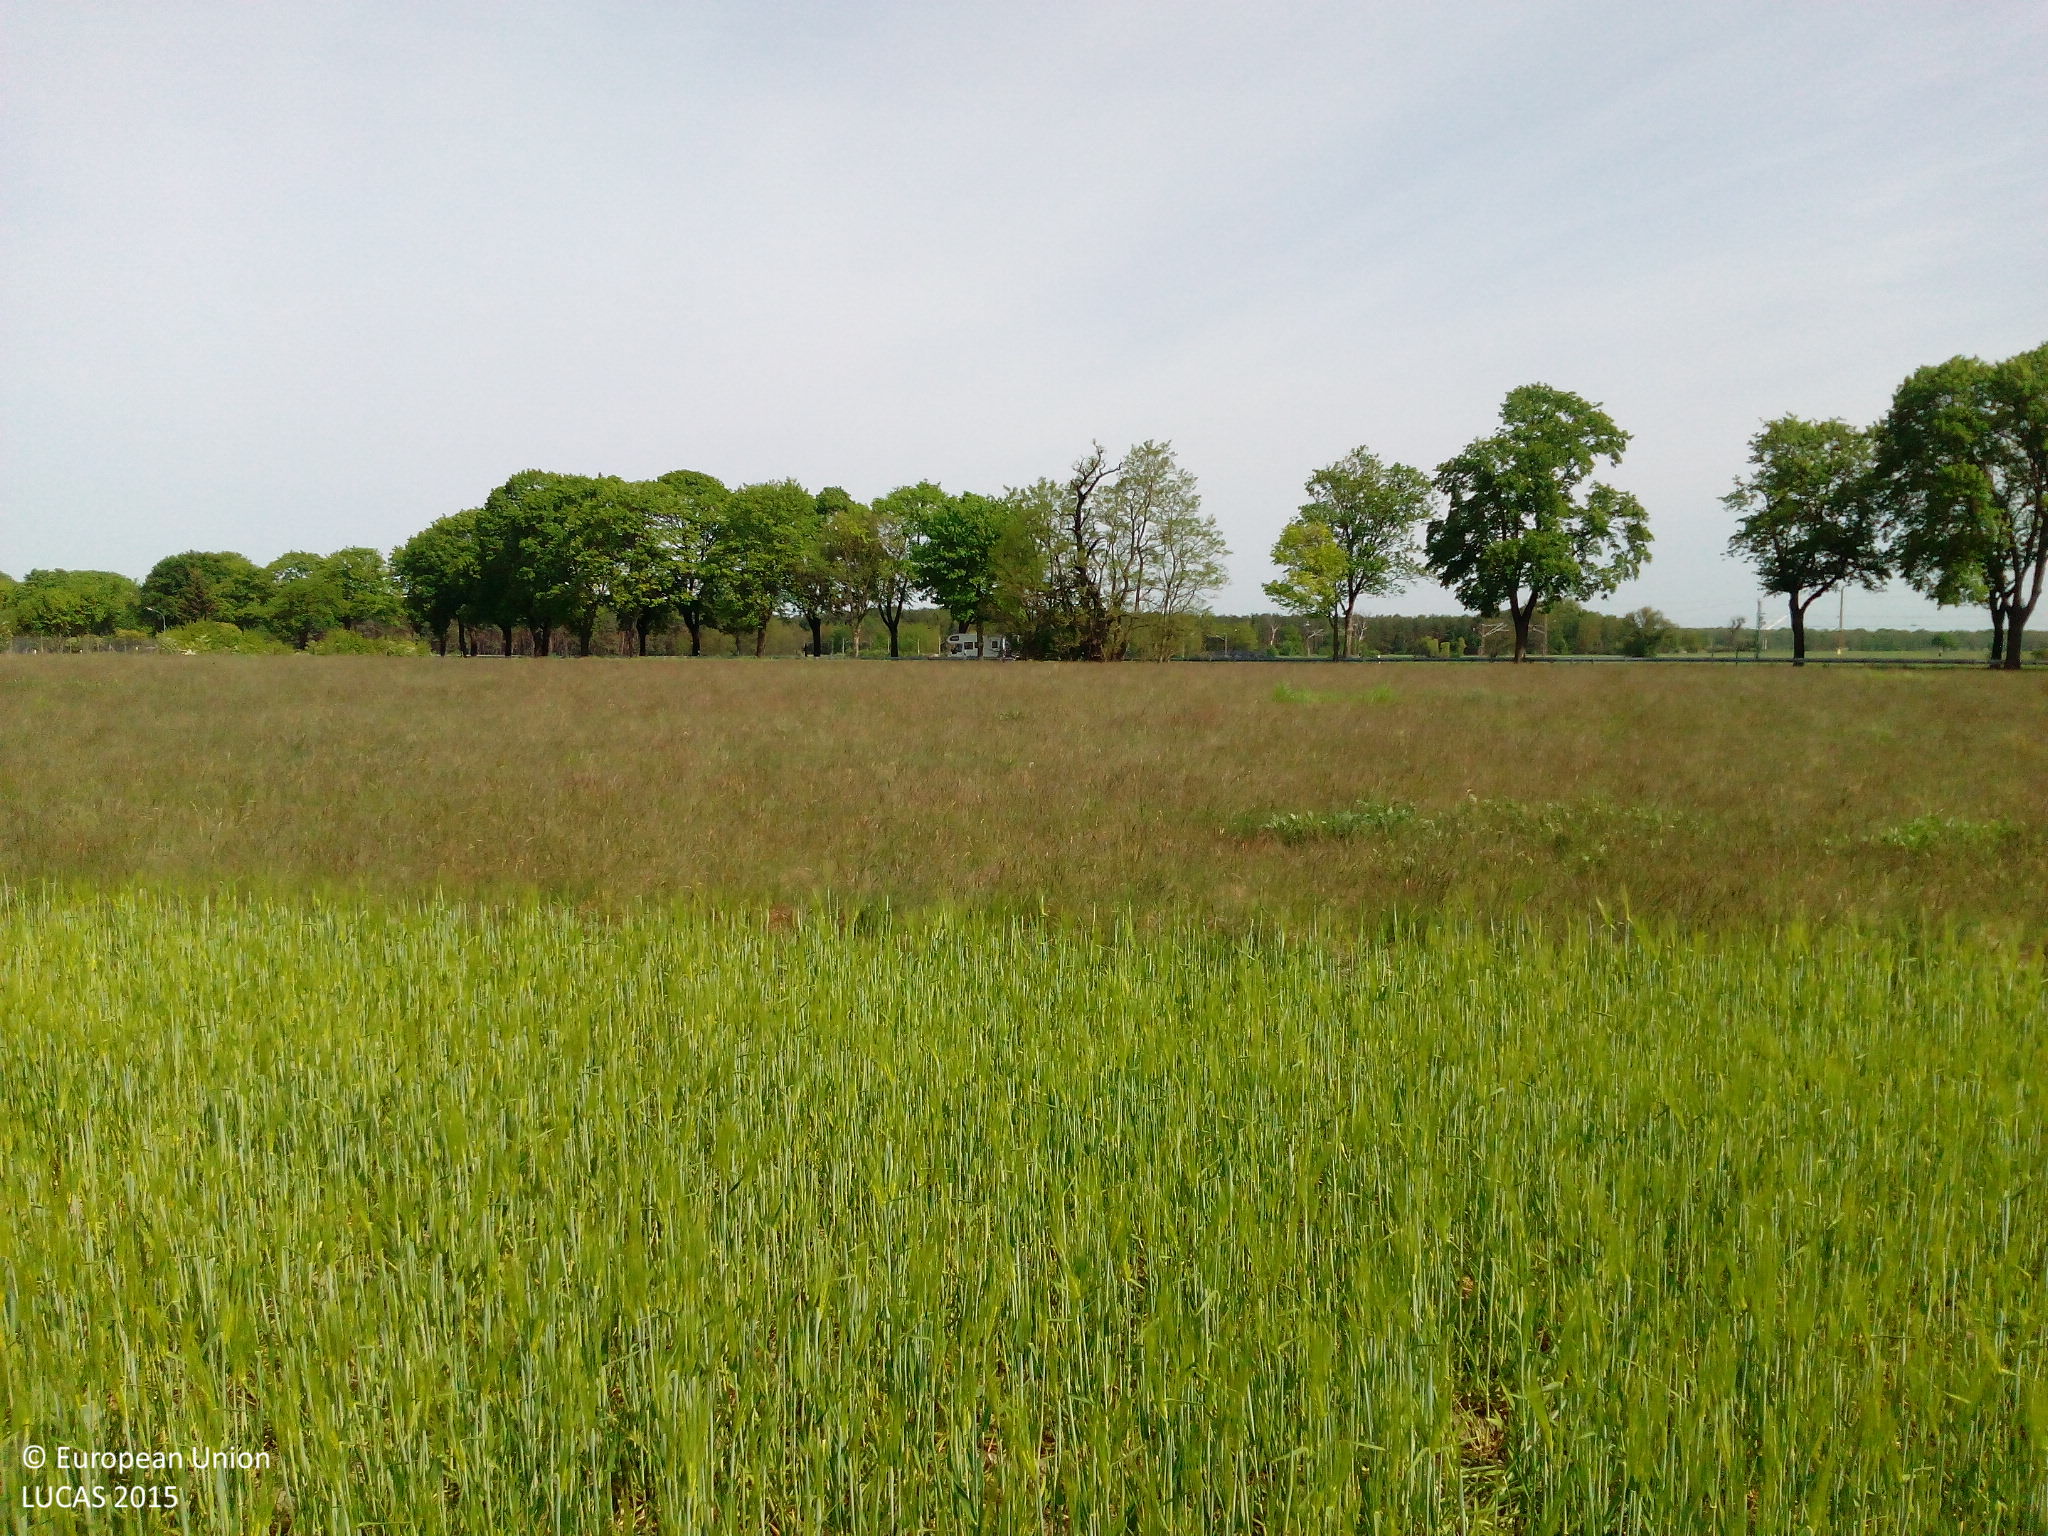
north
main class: Cropland
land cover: Barley
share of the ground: > 75 %
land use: Agriculture (excluding fallow land and kitchen gardens)
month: May
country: DE
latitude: 51.9821
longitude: 13.5676
